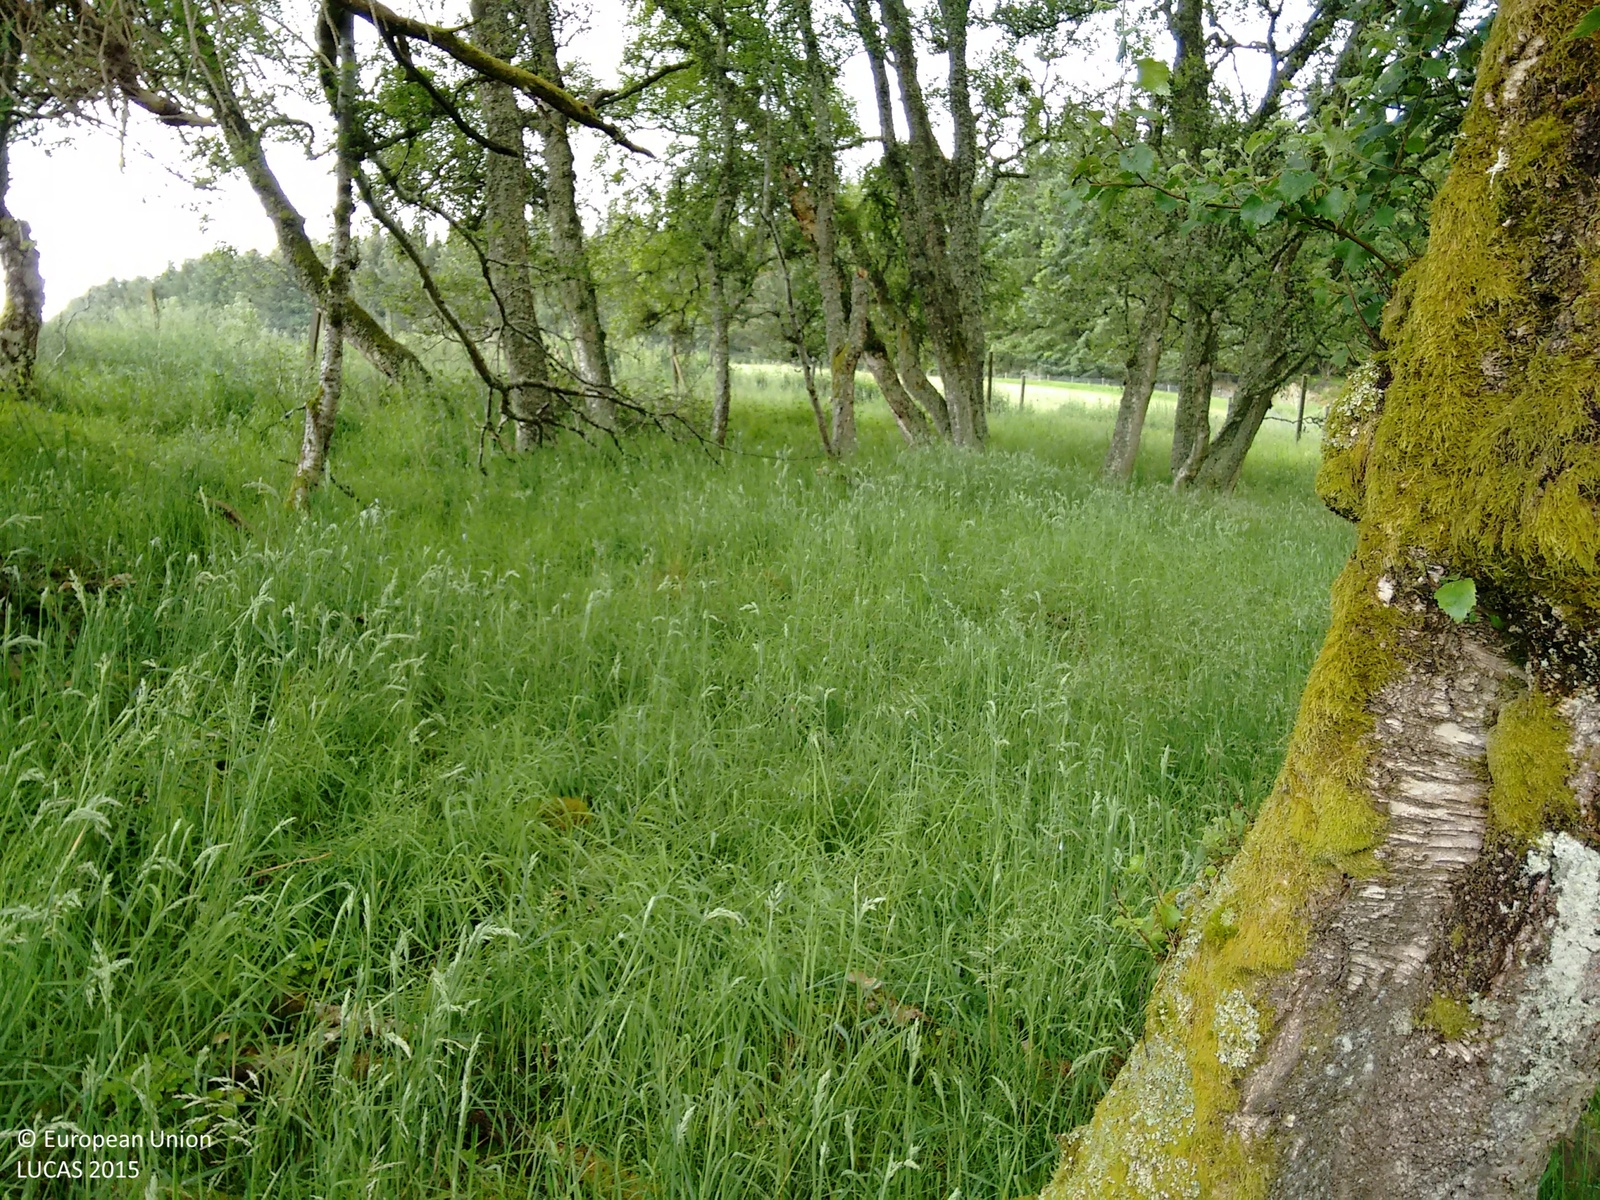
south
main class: Woodland
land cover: Broadleaved woodland
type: mesophytic deciduous forest
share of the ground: > 75 %
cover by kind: broadleaved forest trees 80 %, herbaceous plants 20 %
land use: Semi-natural and natural areas not in use
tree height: > 5 m
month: July
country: GB
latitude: 57.2296
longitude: -2.8985
